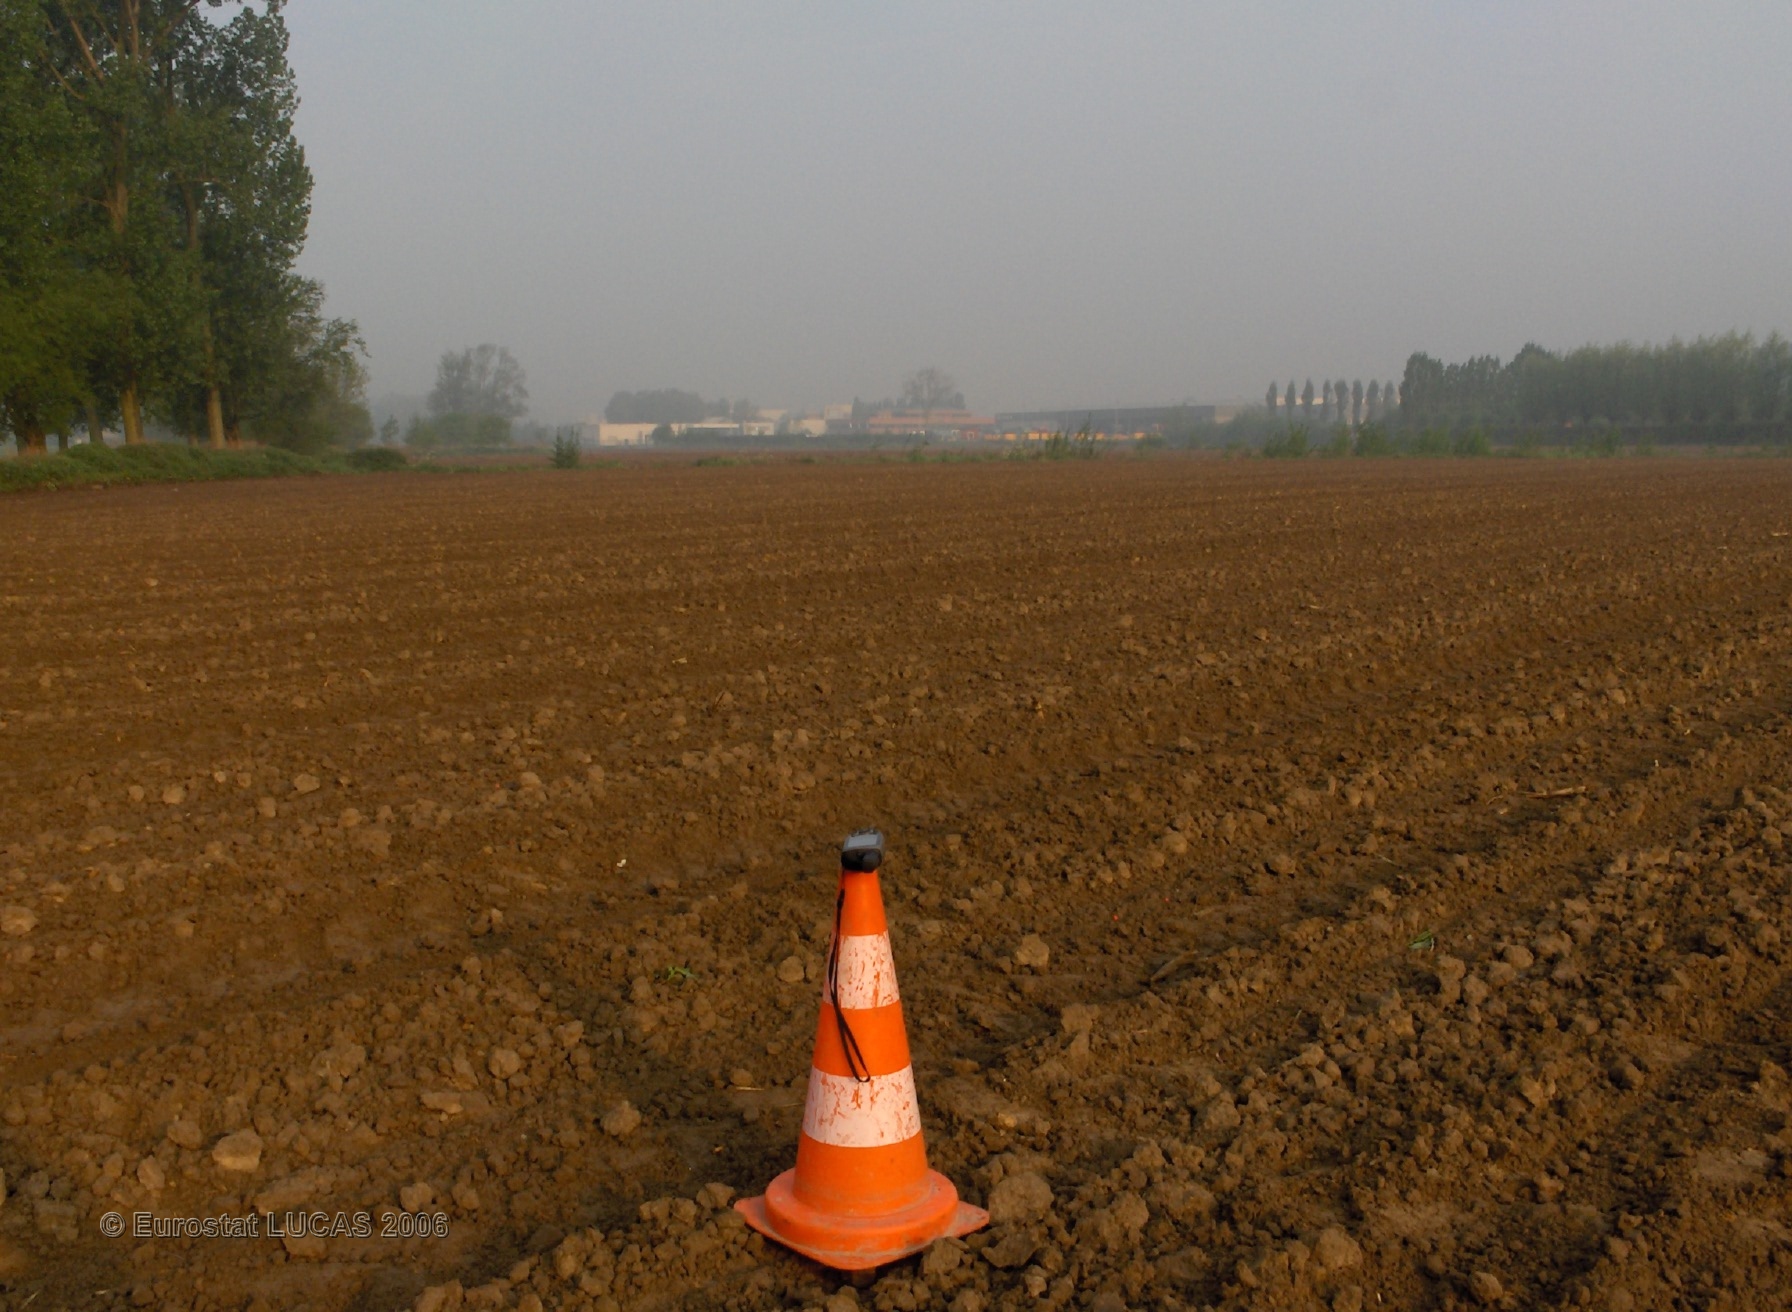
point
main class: Cropland
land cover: Maize
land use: Agriculture (excluding fallow land and kitchen gardens)
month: May
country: BE
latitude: 51.1464
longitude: 4.4062
